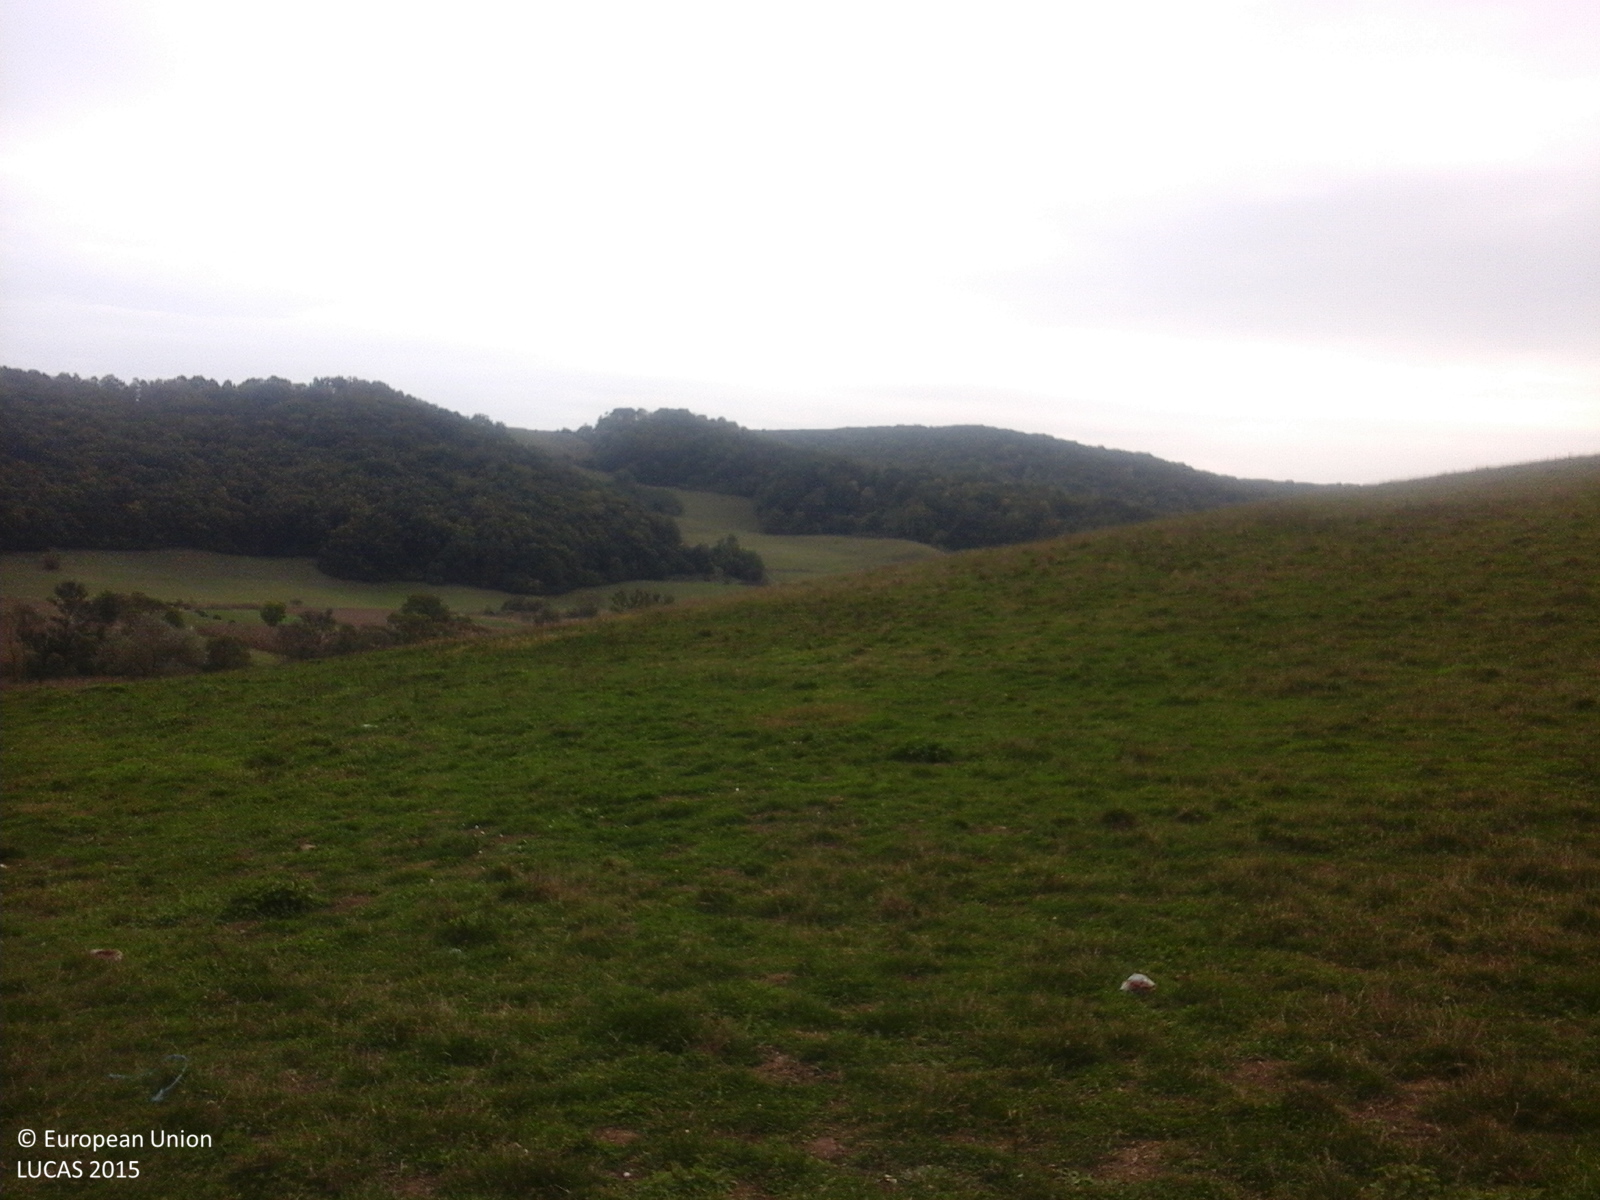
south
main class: Grassland
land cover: Grassland without tree/shrub cover
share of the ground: > 75 %
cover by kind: herbaceous plants 100 %
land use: Agriculture (excluding fallow land and kitchen gardens)
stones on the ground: < 10 %
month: October
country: RO
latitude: 46.5525
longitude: 24.8458
